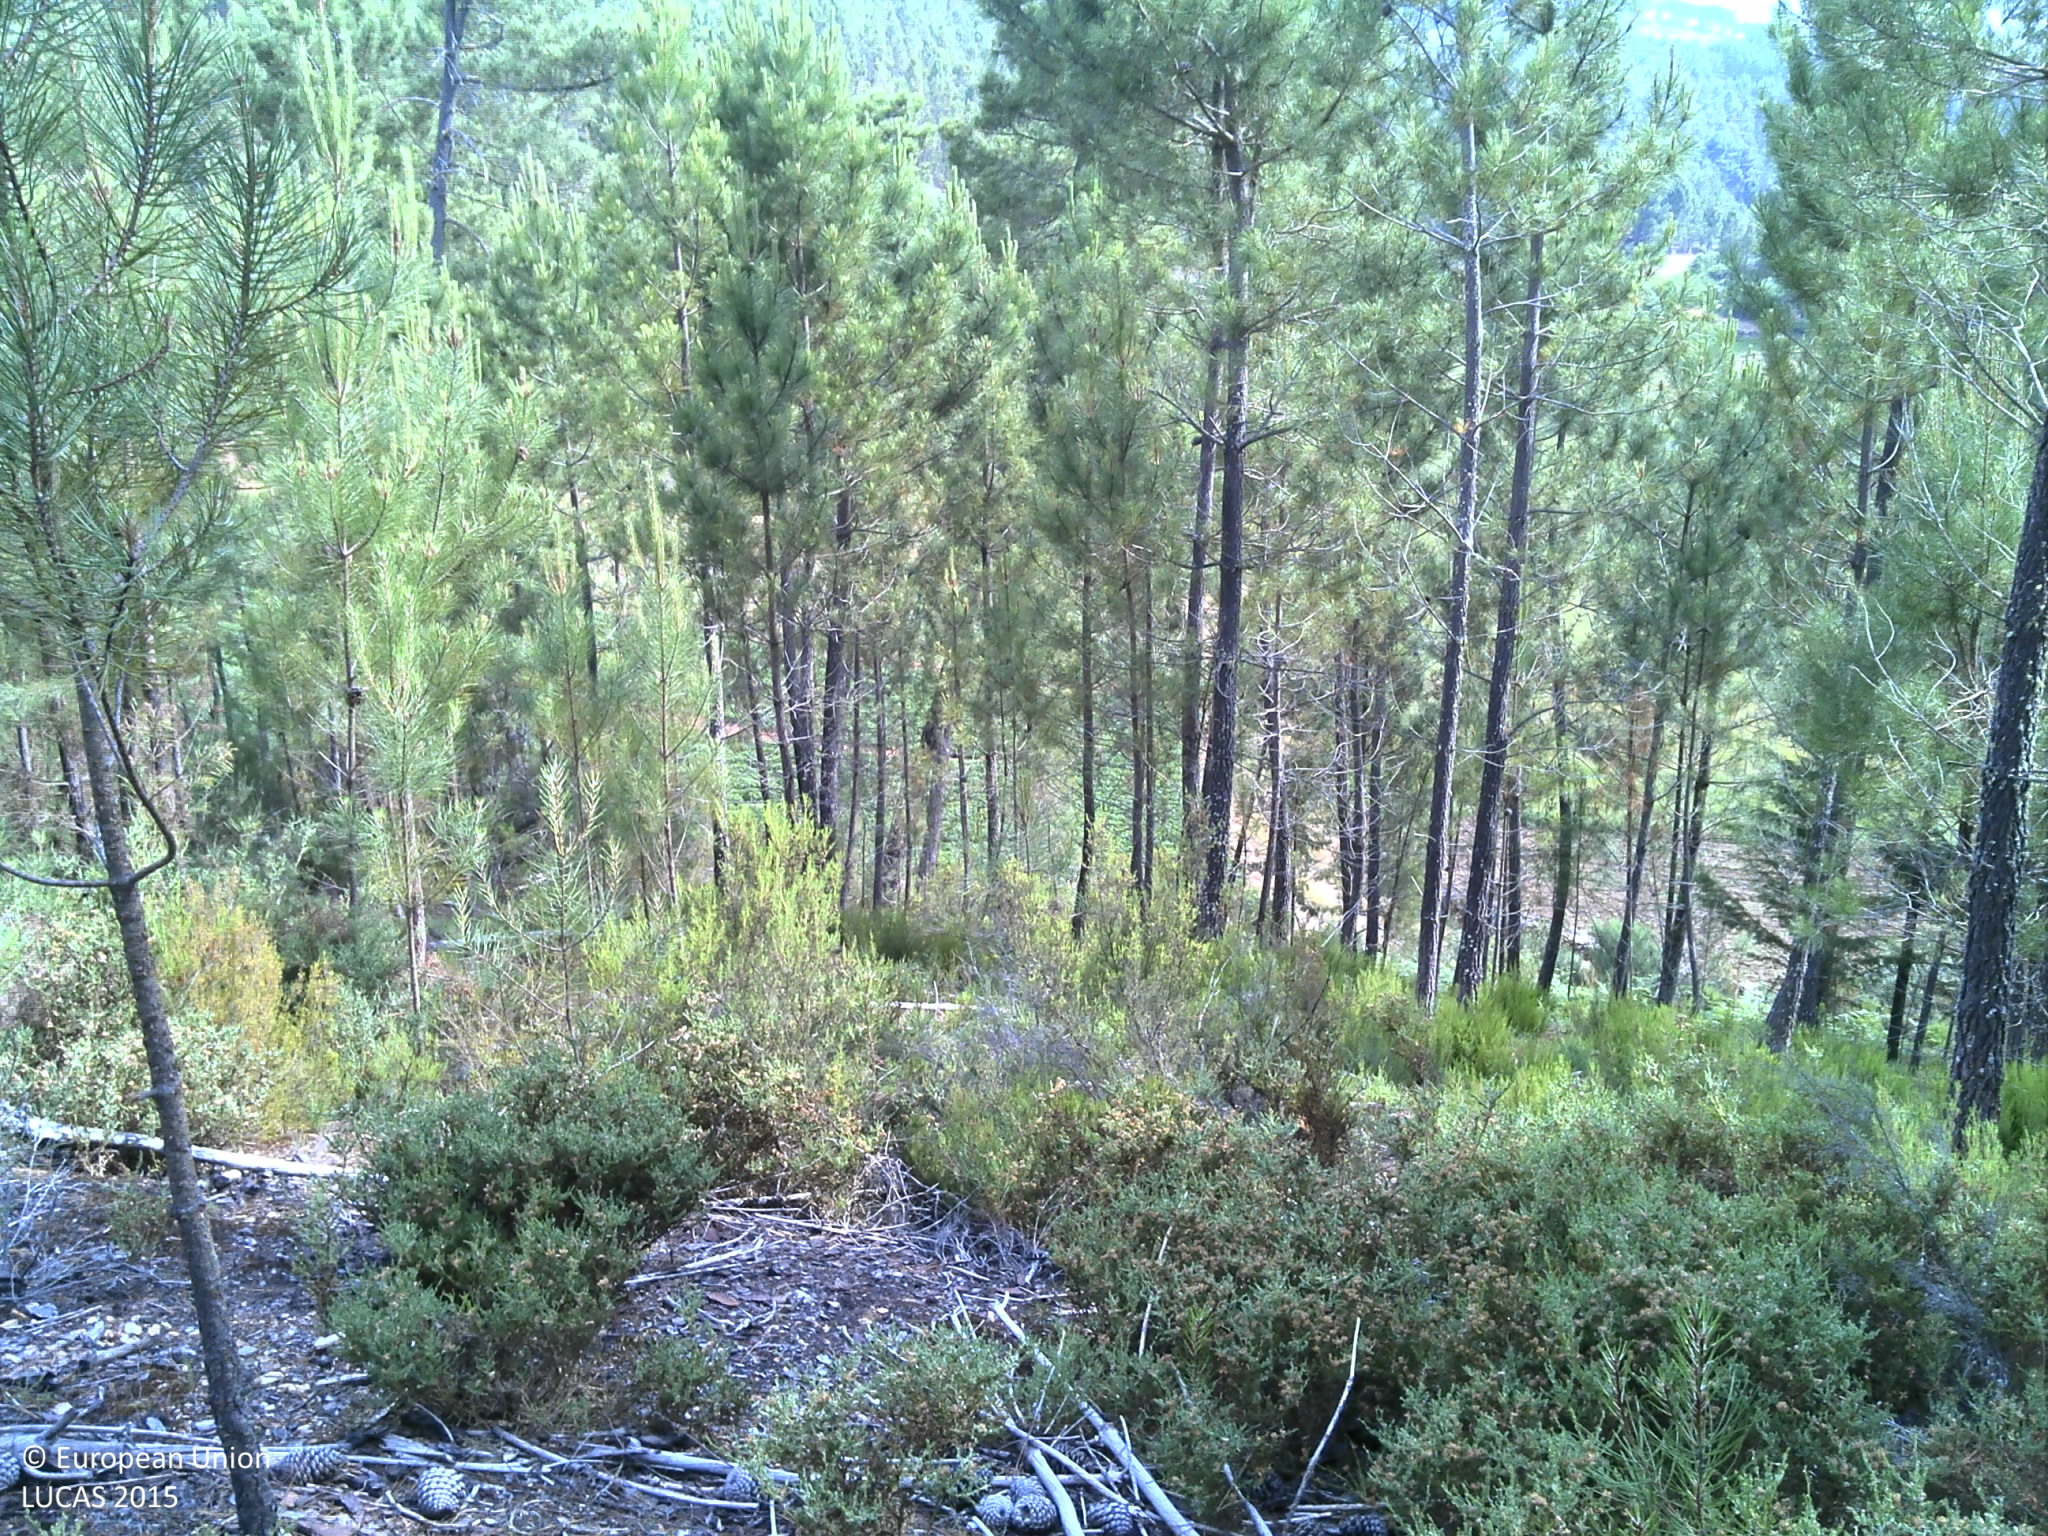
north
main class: Woodland
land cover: Pine dominated coniferous woodland
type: coniferous forest of the mediterranean region
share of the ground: 25 - 50 %
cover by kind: coniferous forest trees 30 %, shrubs 20 %, unconsolidated bare surface 20 %, lichens and mosses 10 %, consolidated bare surface 10 %
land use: Forestry
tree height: > 5 m
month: June
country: PT
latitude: 41.4626
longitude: -7.5234
